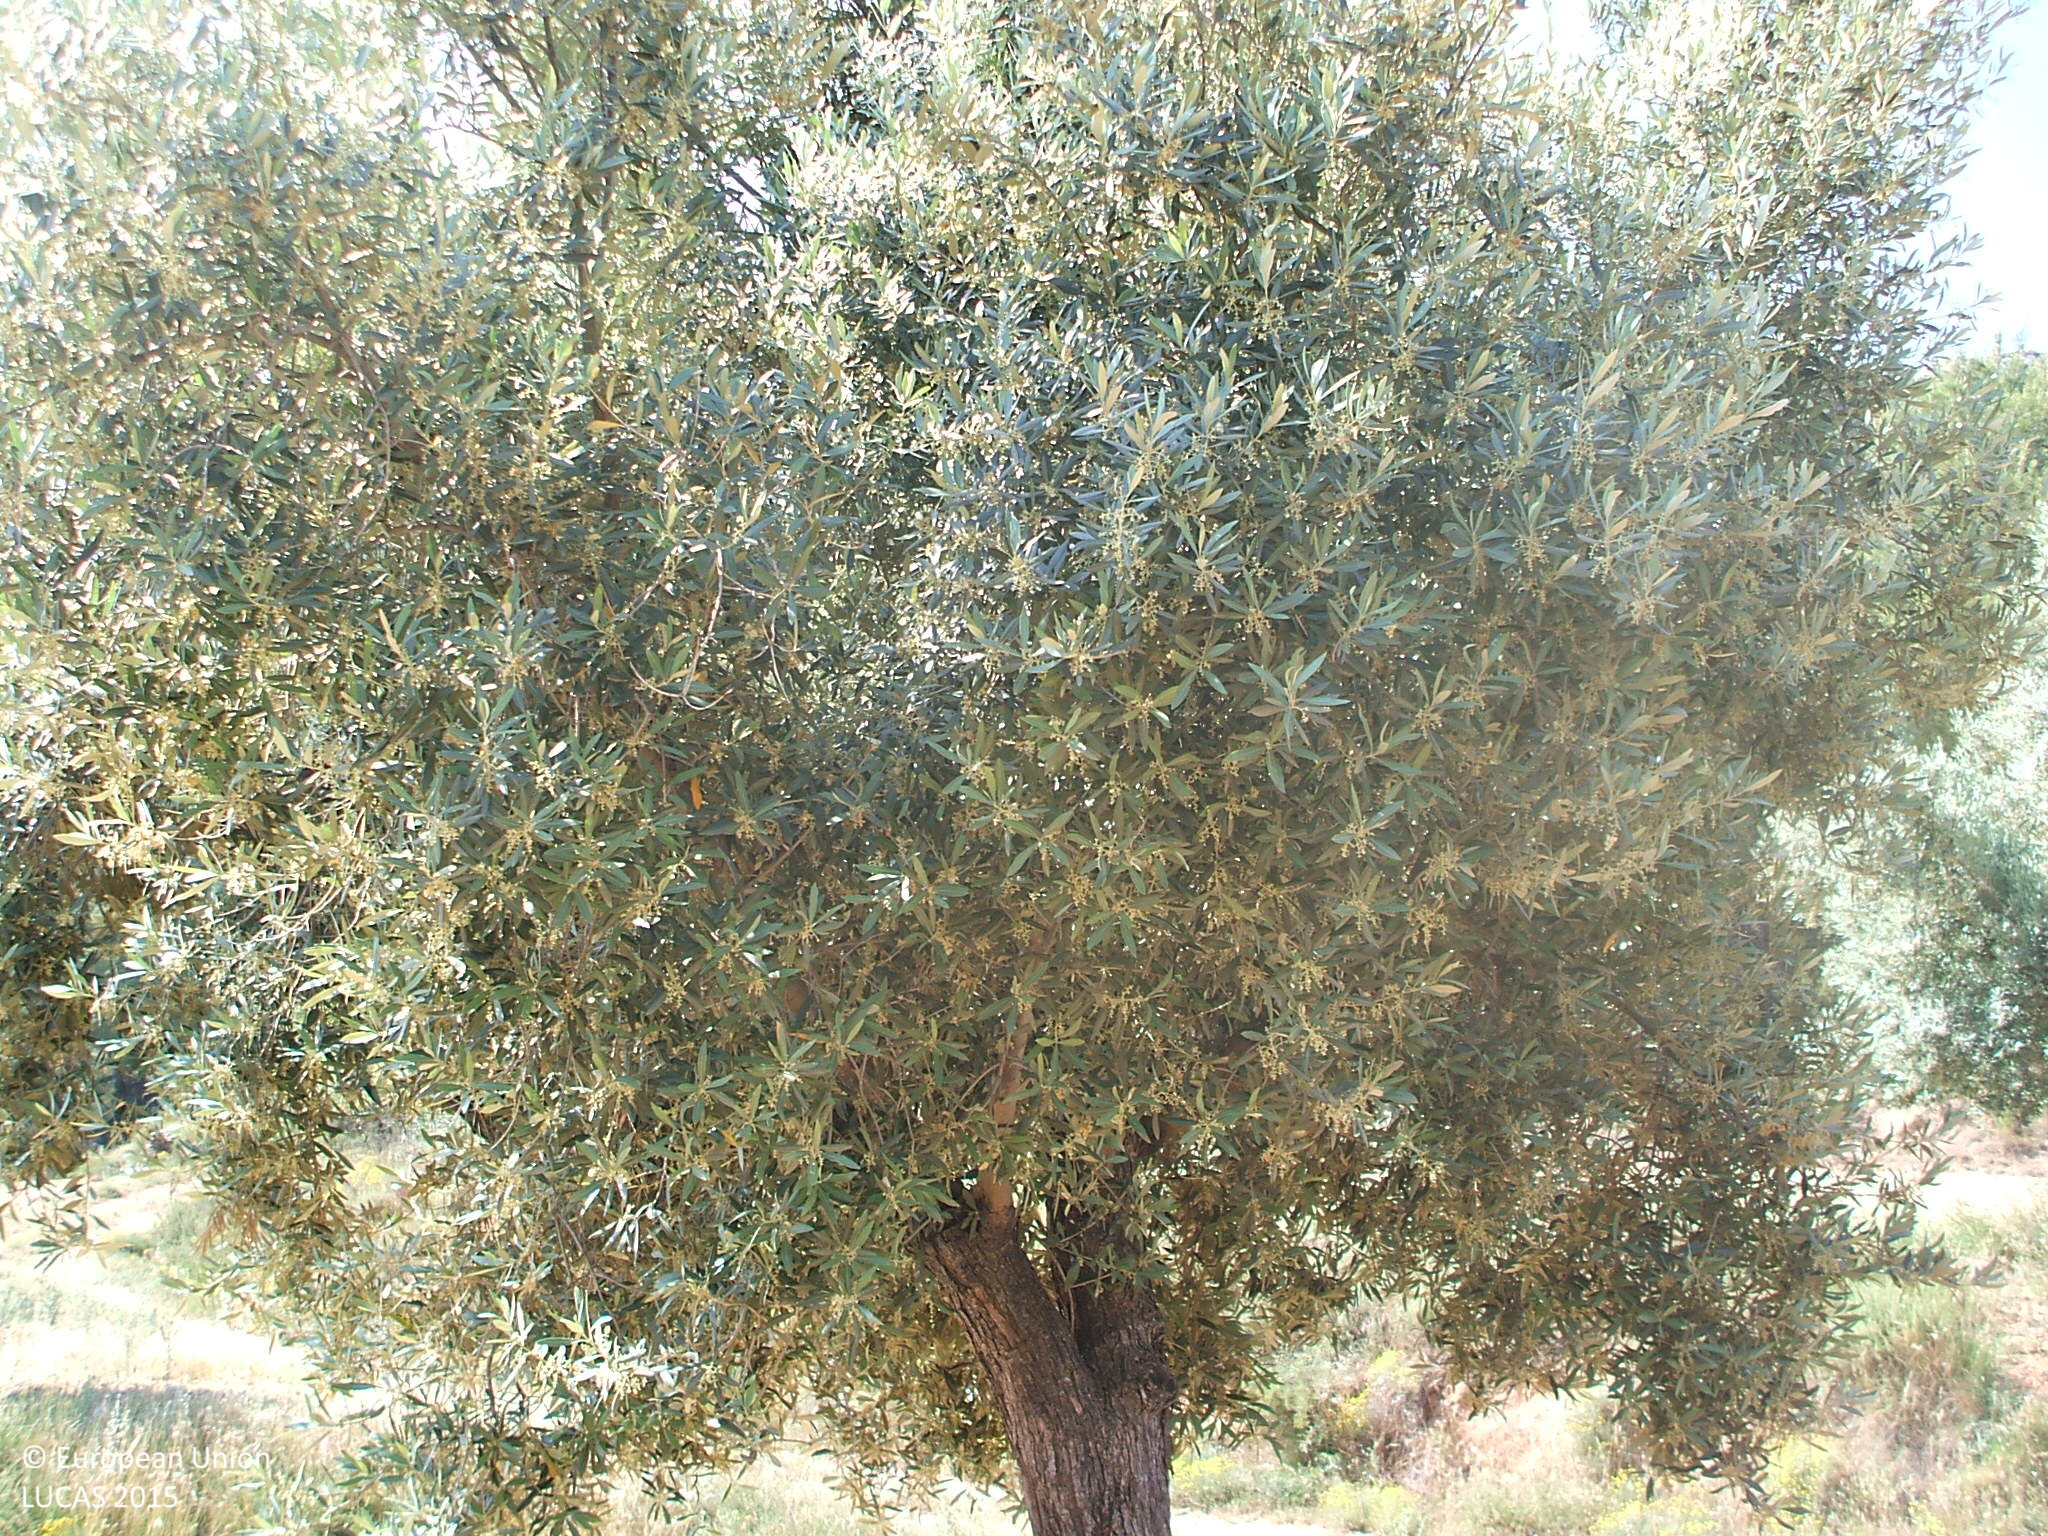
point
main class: Cropland
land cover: Olive groves
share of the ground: 25 - 50 %
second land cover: Other bare soil
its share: > 75 %
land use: Agriculture (excluding fallow land and kitchen gardens)
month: June
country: ES
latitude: 40.9125
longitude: -0.2571
